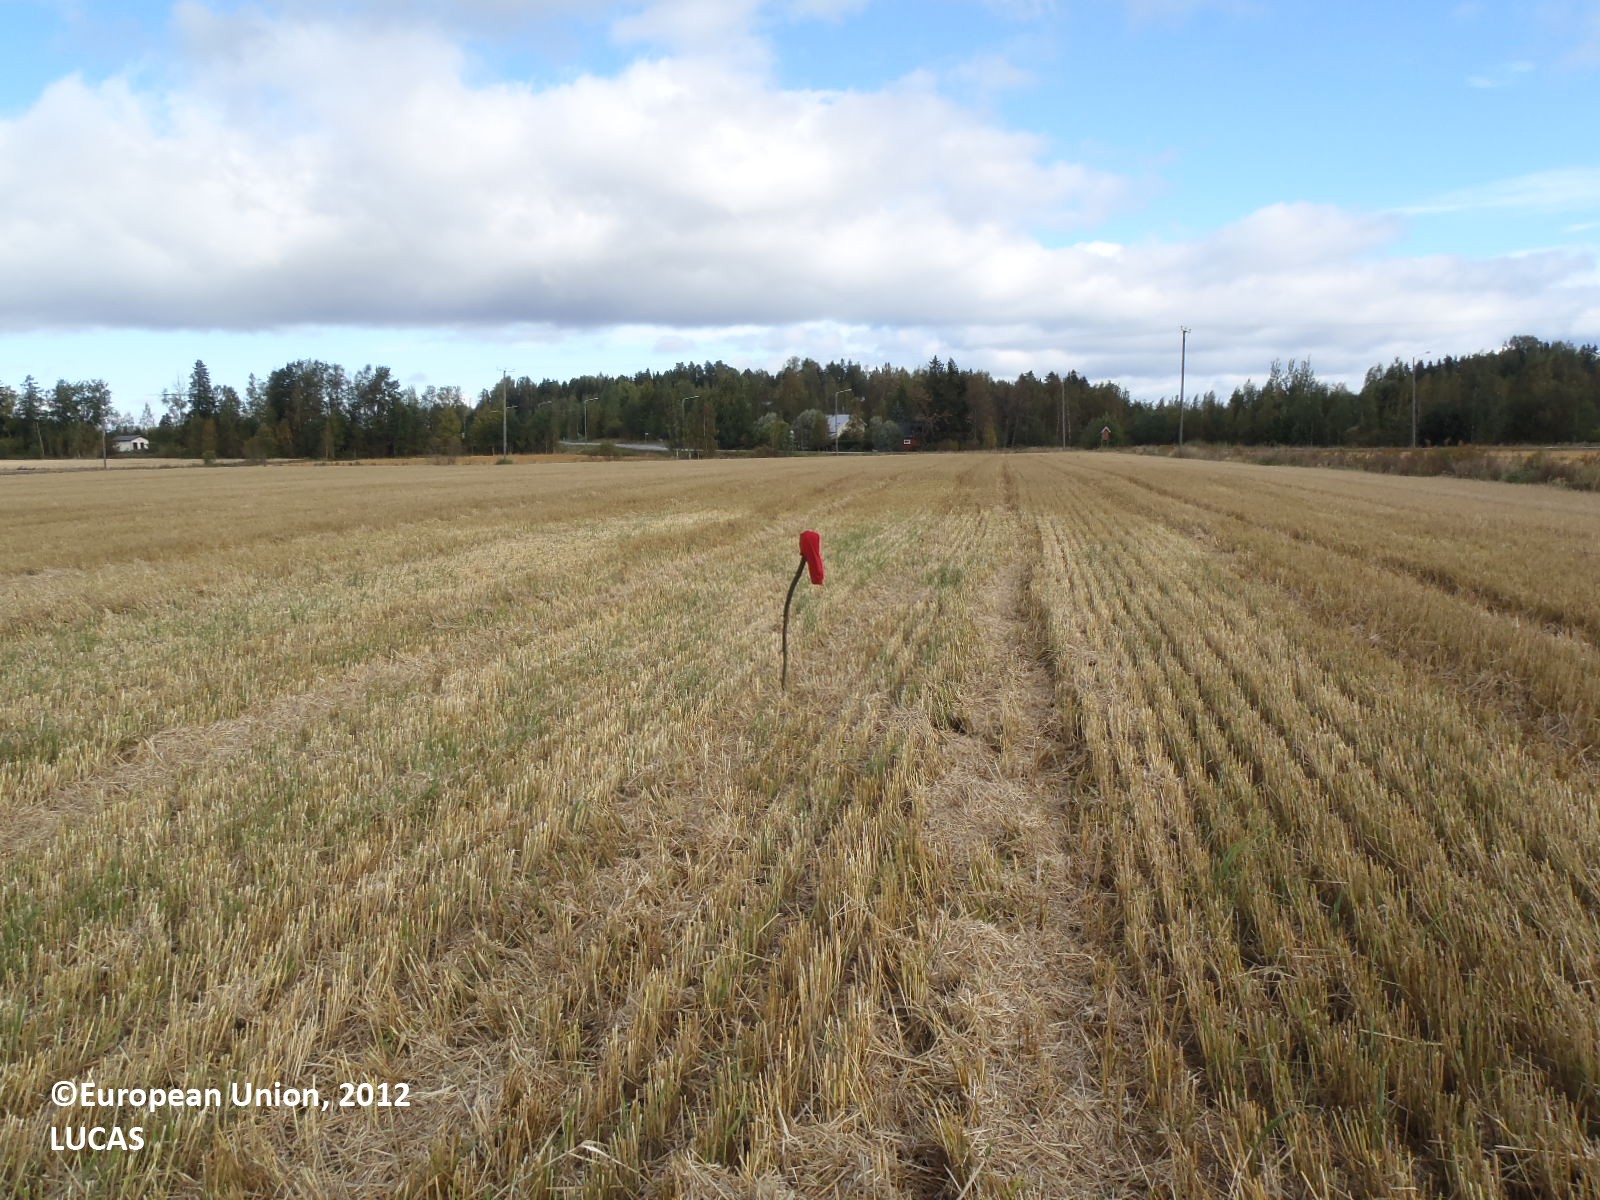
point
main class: Cropland
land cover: Barley
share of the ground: > 75 %
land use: Agriculture (excluding fallow land and kitchen gardens)
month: September
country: FI
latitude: 61.3350
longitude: 22.7575
